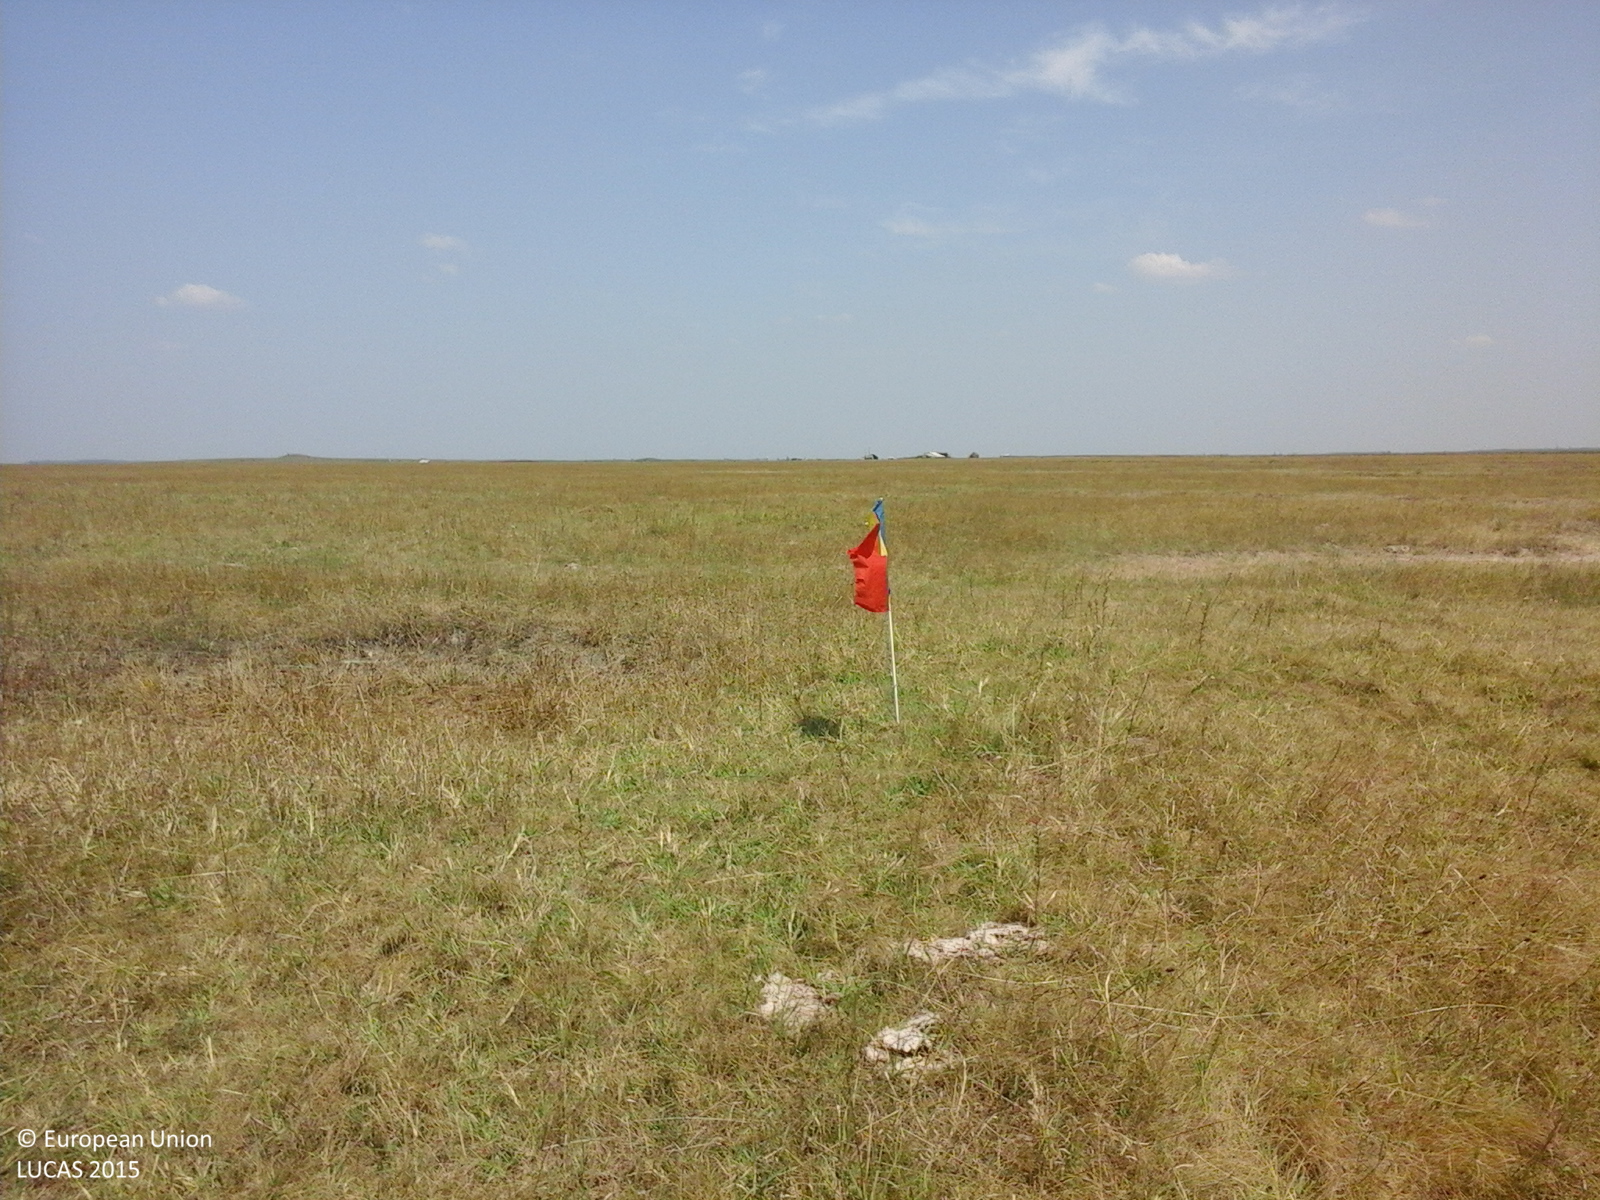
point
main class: Grassland
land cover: Grassland without tree/shrub cover
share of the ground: > 75 %
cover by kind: herbaceous plants 100 %
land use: Agriculture (excluding fallow land and kitchen gardens)
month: August
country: RO
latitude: 45.0106
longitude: 26.6838
